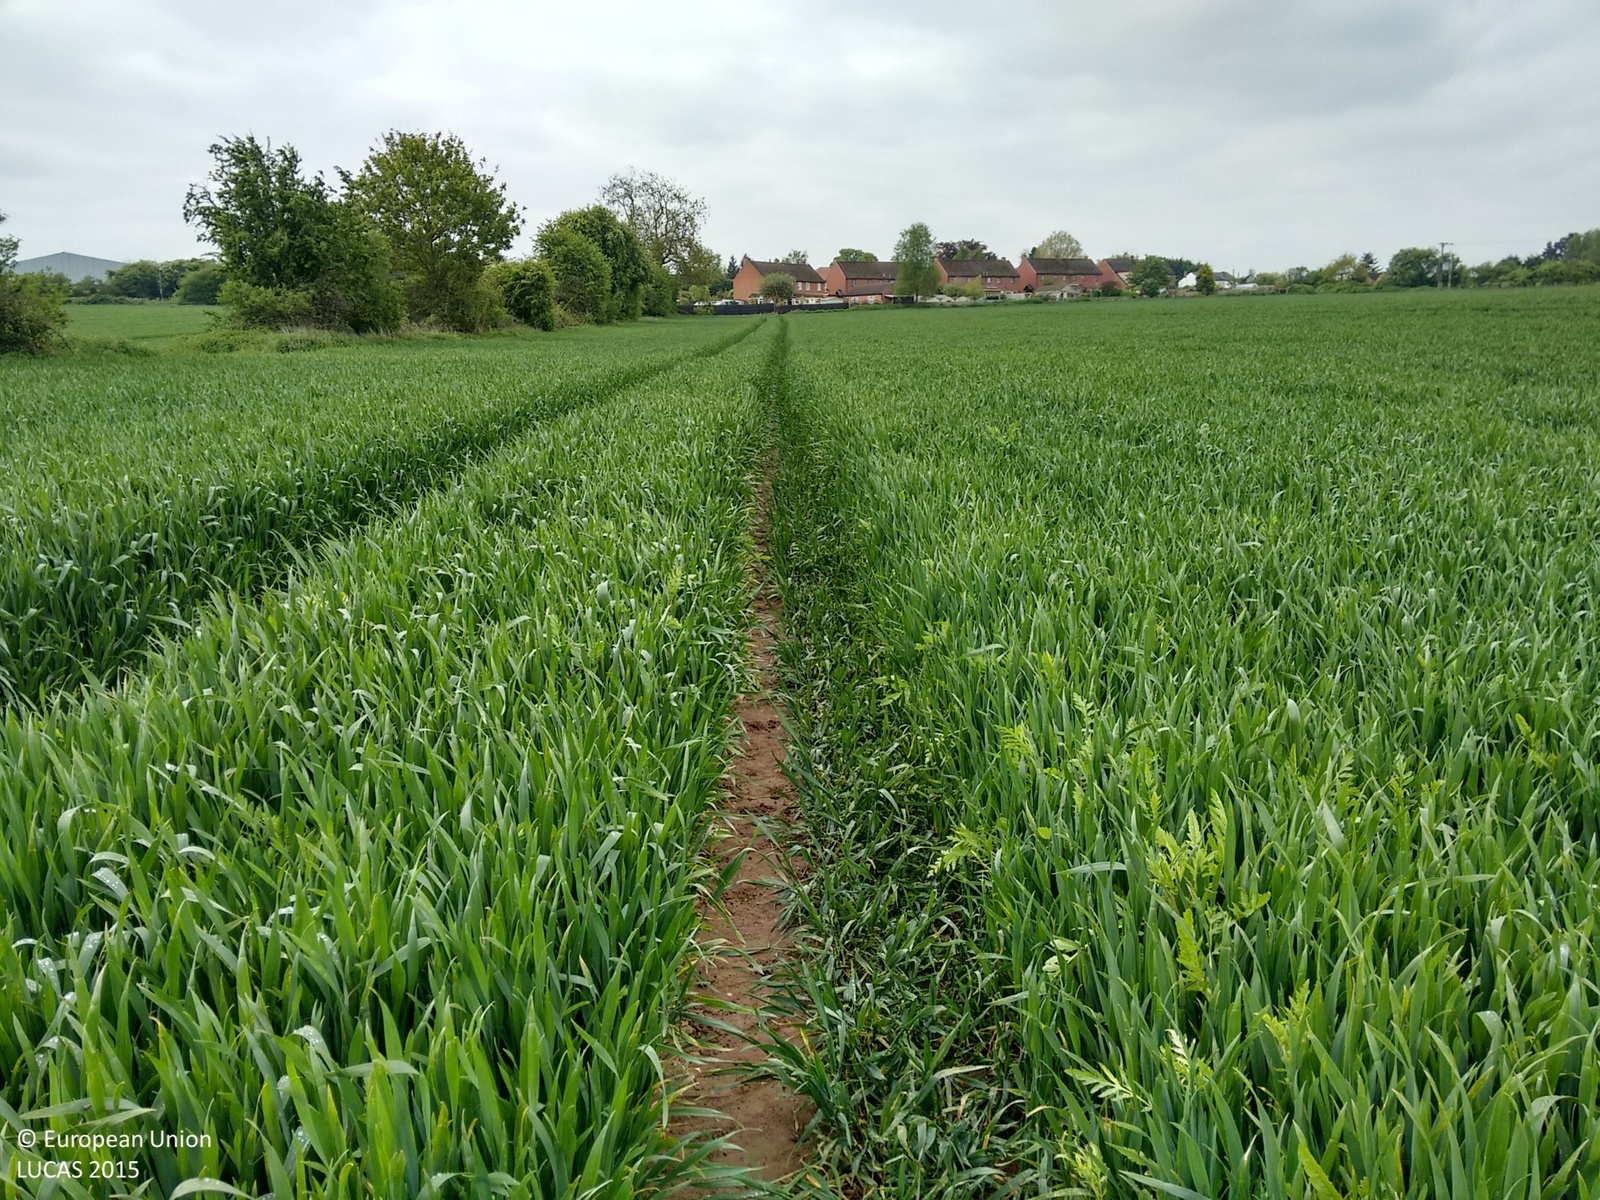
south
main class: Cropland
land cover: Common wheat
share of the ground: > 75 %
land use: Agriculture (excluding fallow land and kitchen gardens)
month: May
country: GB
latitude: 52.4352
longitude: -1.3007
